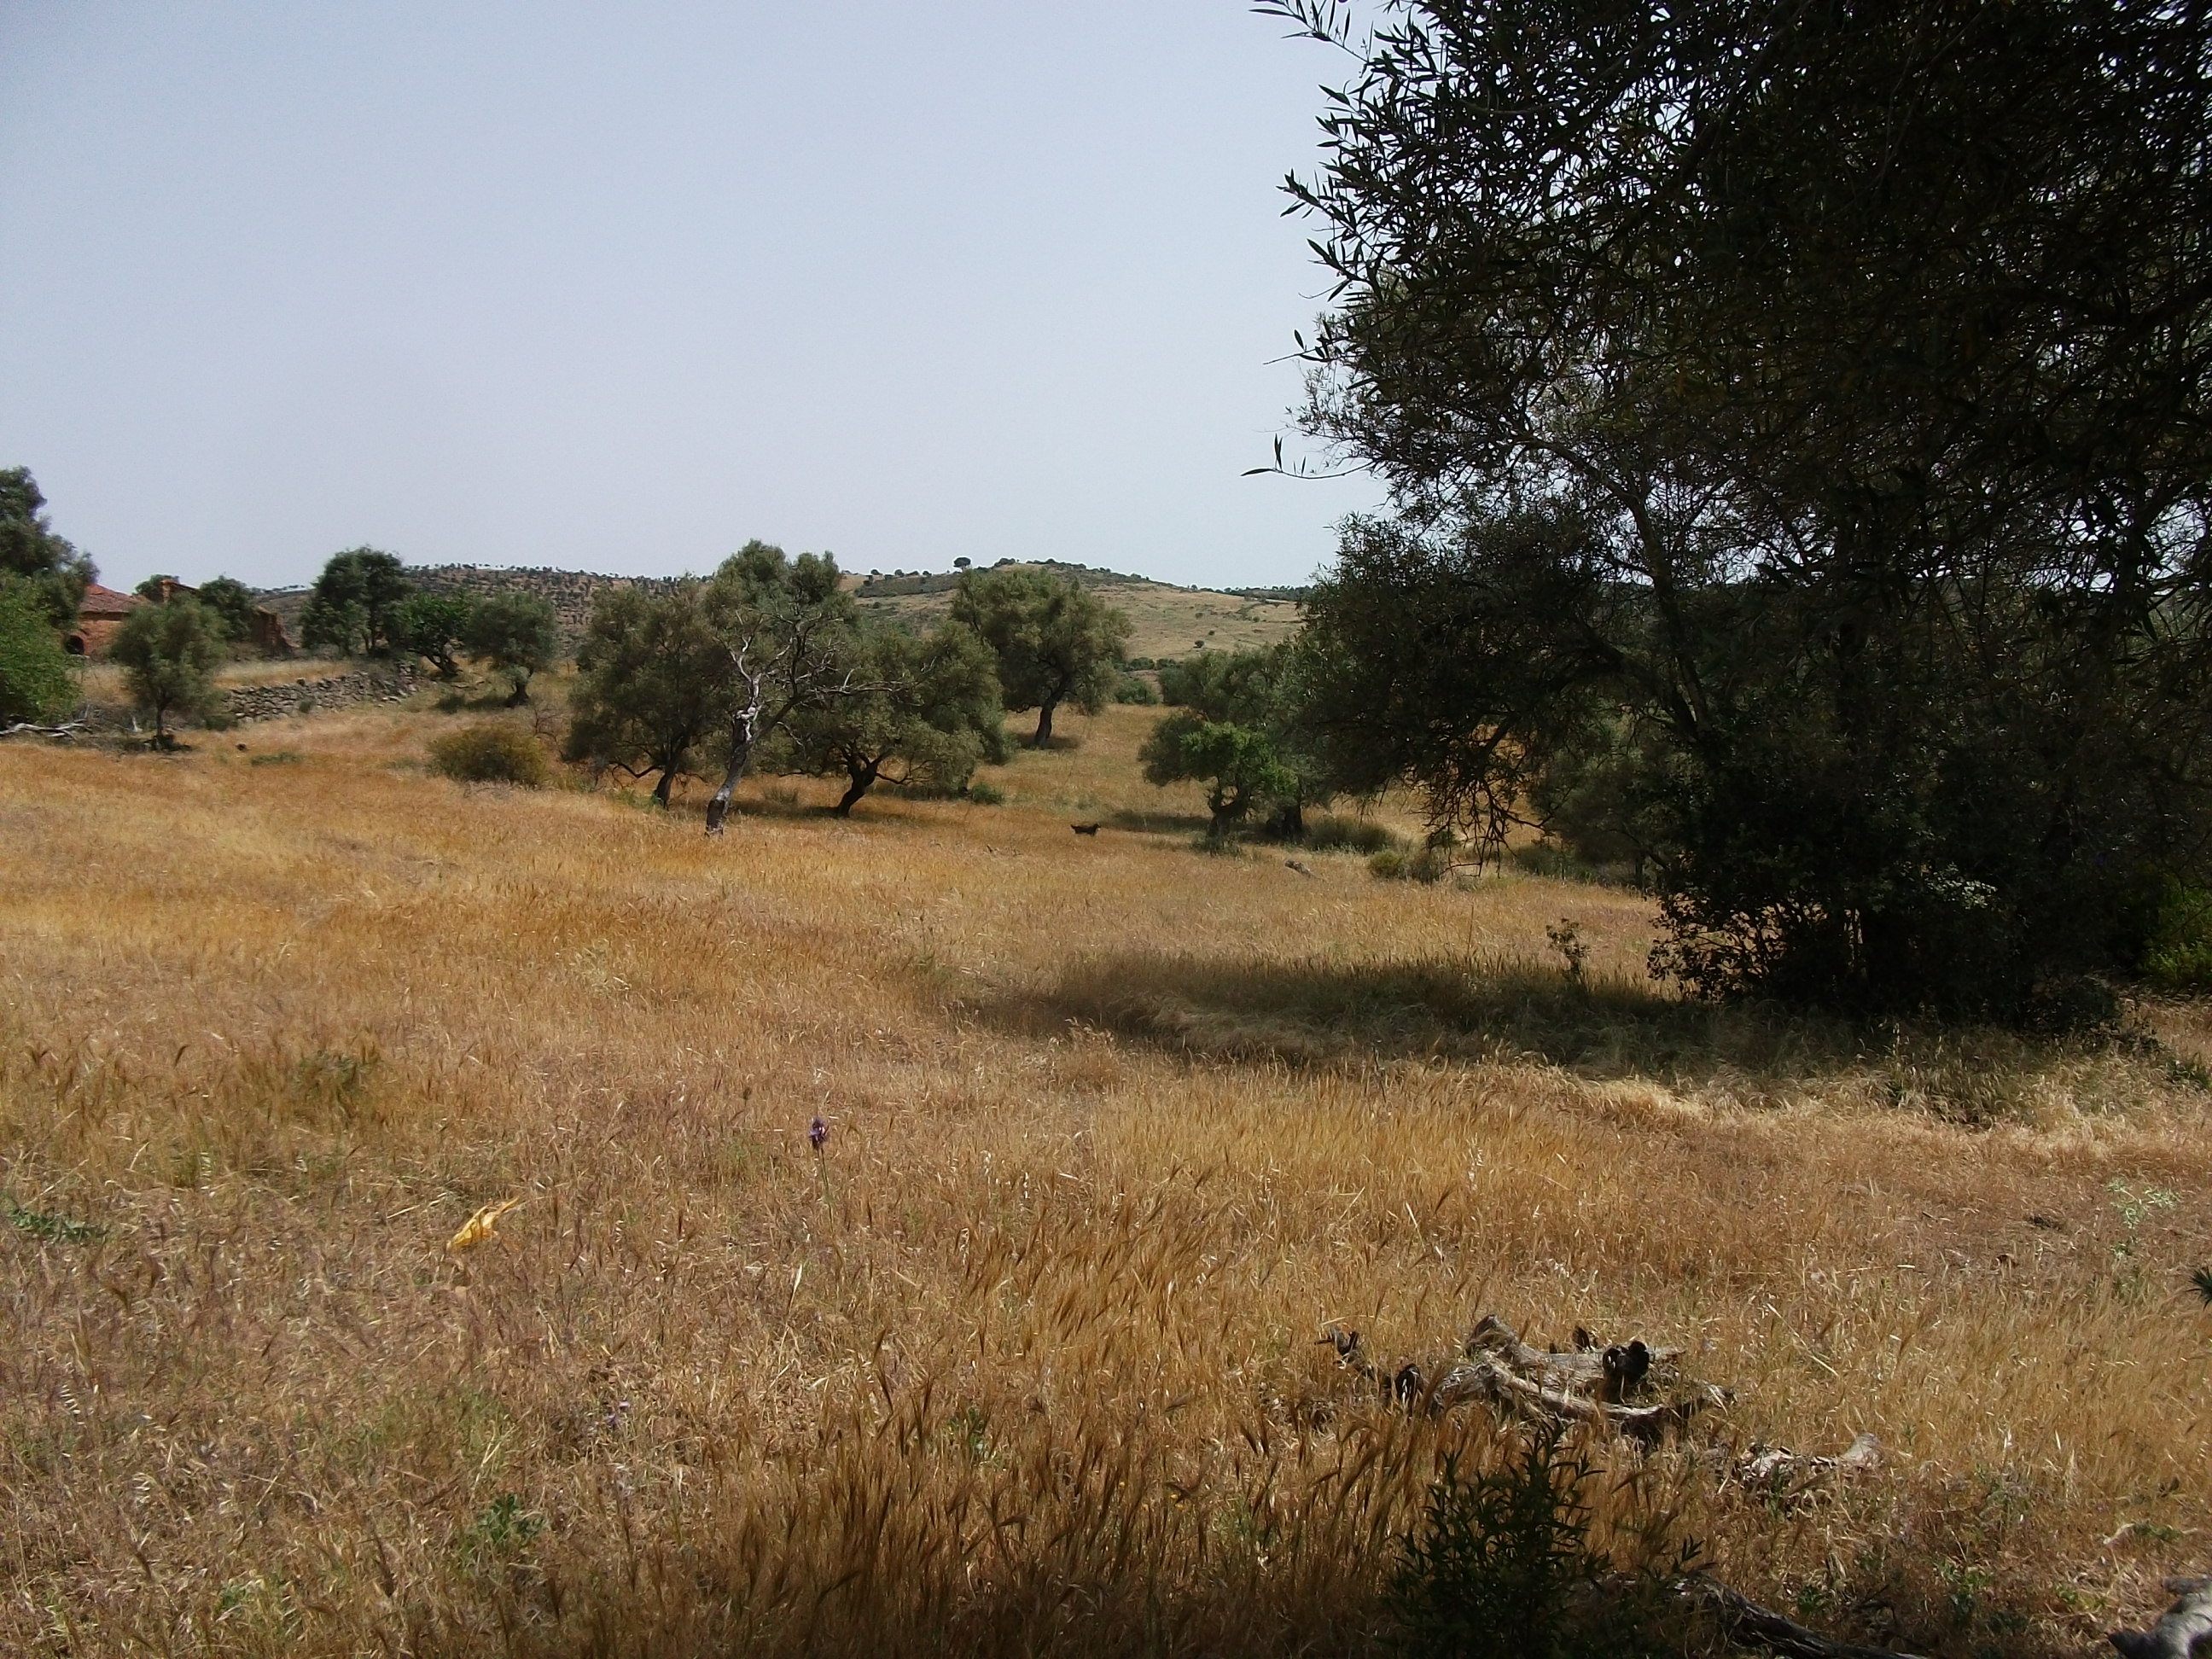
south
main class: Cropland
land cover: Olive groves
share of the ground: 25 - 50 %
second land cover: Spontaneously vegetated surfaces
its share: > 75 %
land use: Agriculture (excluding fallow land and kitchen gardens)
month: May
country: ES
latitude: 37.7259
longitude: -6.9646
